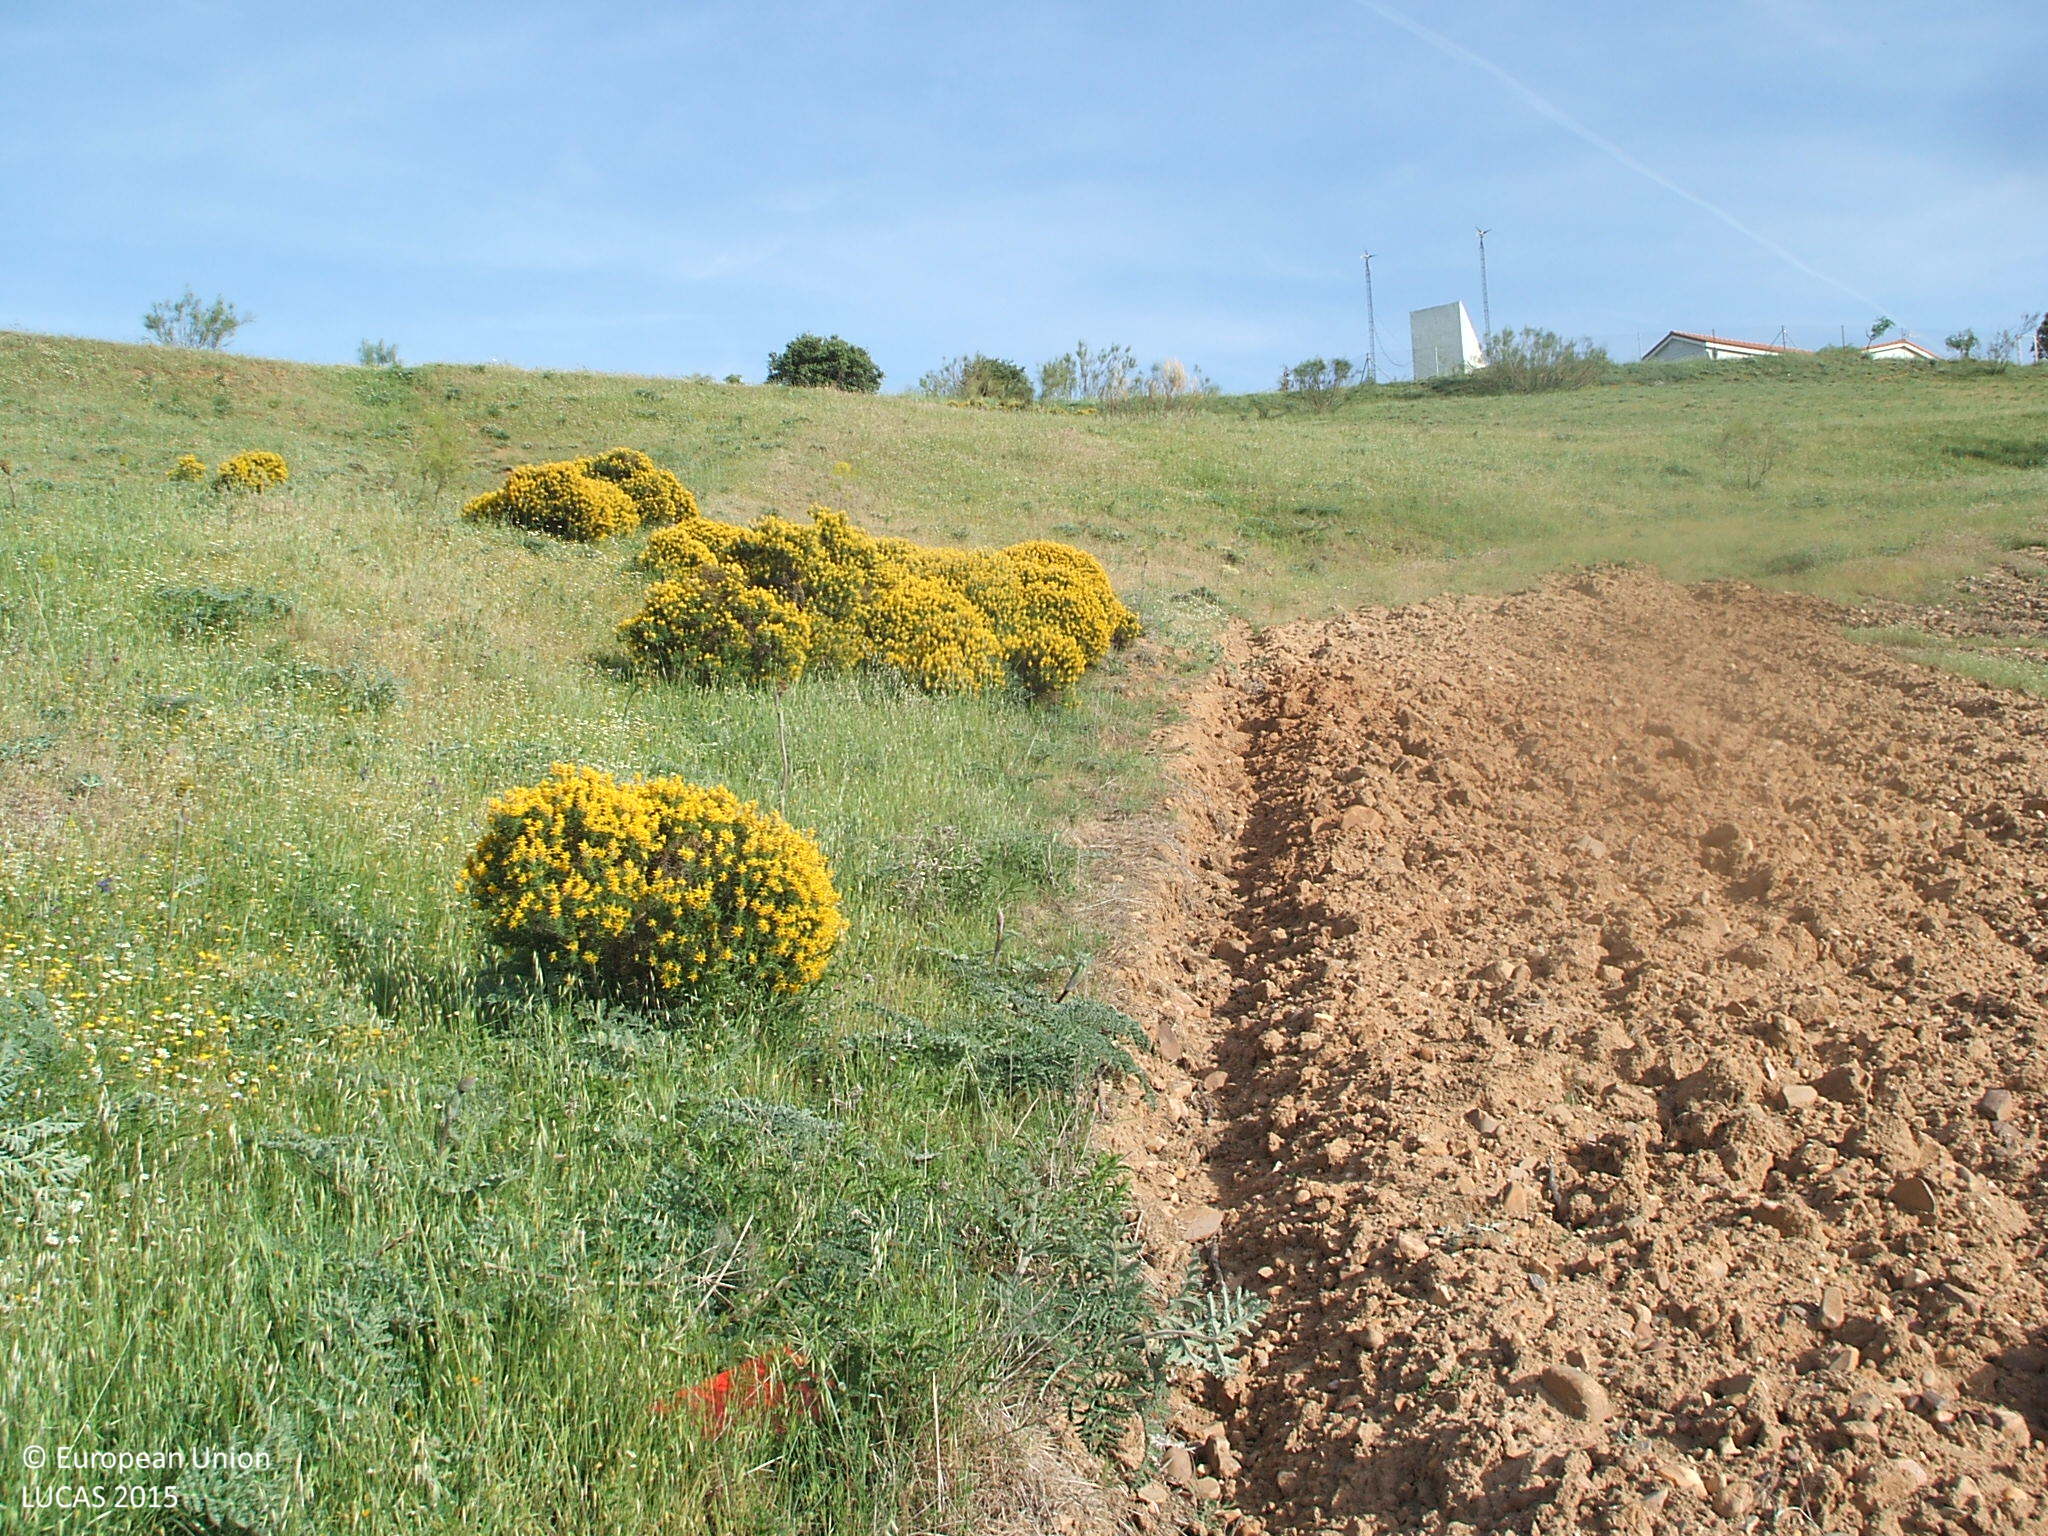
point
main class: Grassland
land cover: Grassland with sparse tree/shrub cover
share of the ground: > 75 %
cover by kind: herbaceous plants 95 %, broadleaved forest trees 5 %
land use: Abandoned areas
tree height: > 5 m
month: May
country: ES
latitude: 40.6921
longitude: -3.4451
